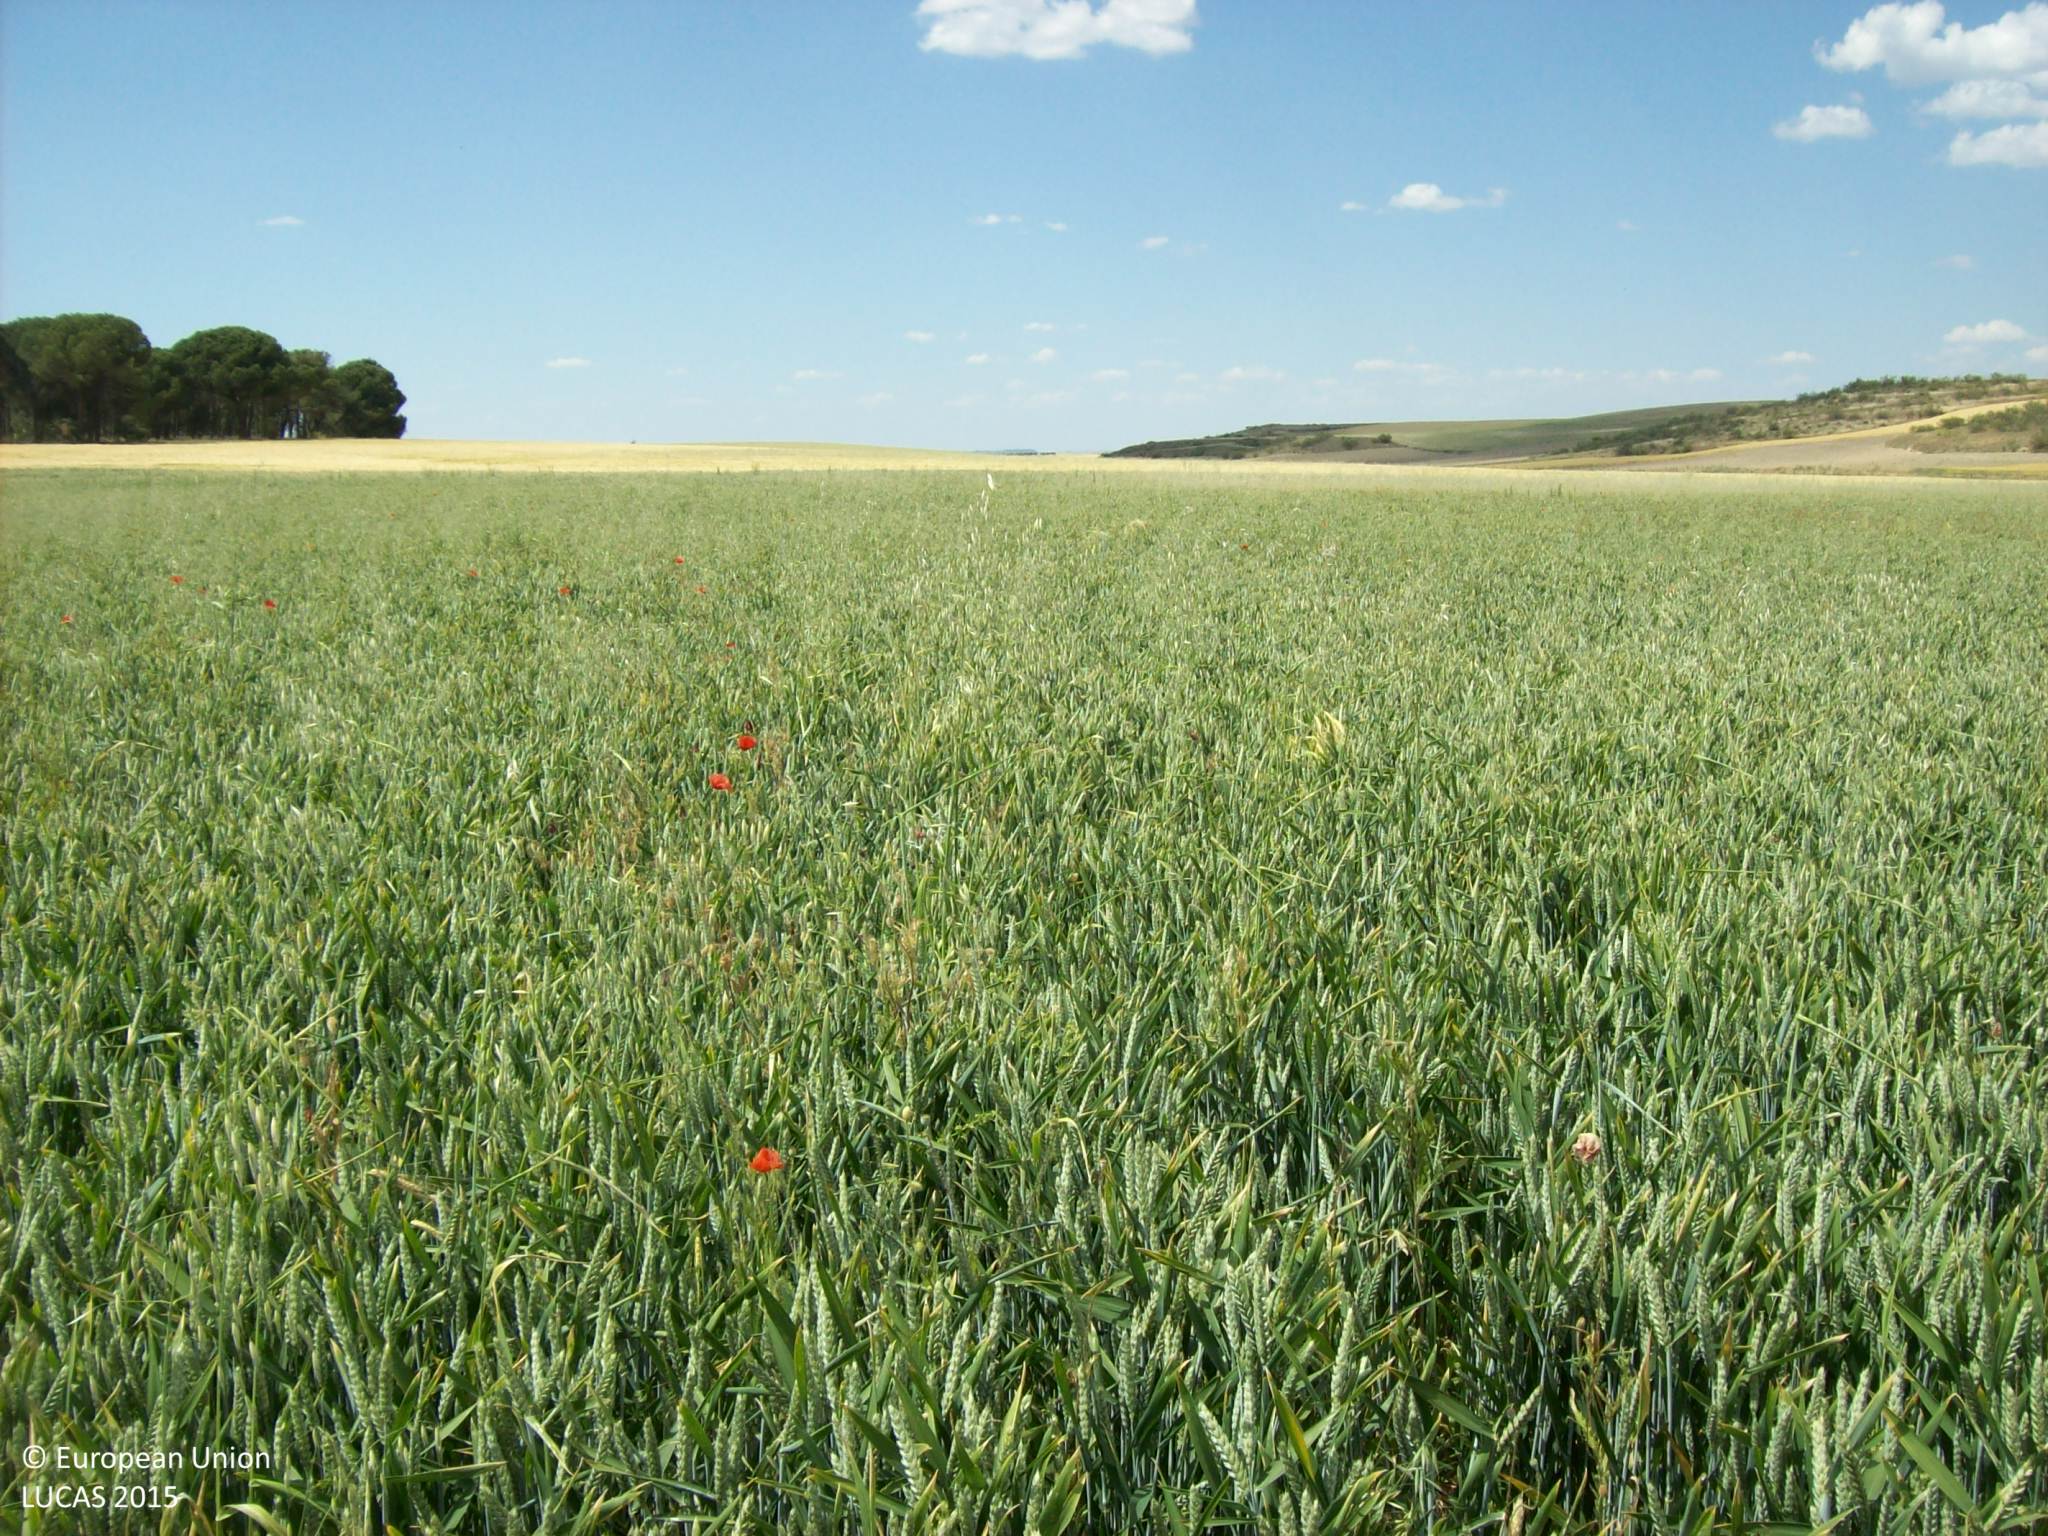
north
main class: Cropland
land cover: Common wheat
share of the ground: > 75 %
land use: Agriculture (excluding fallow land and kitchen gardens)
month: June
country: ES
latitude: 41.1376
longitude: -4.5581
